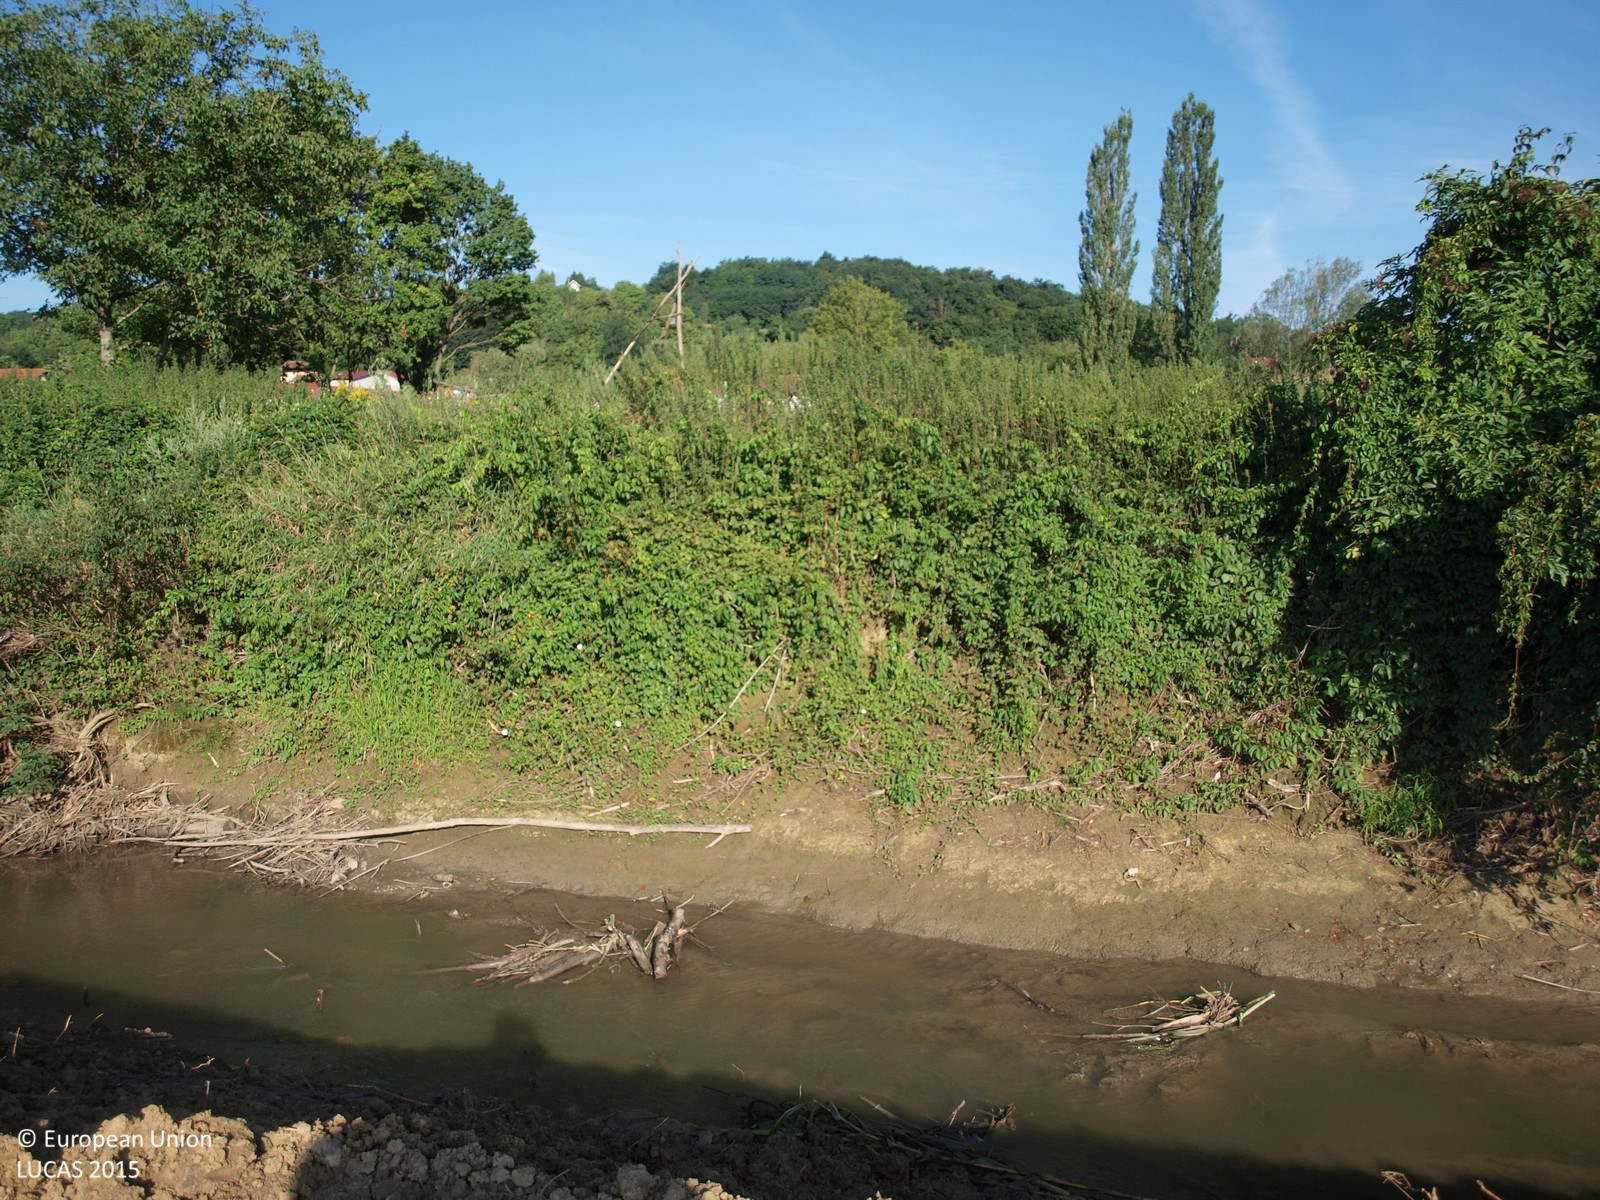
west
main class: Shrubland
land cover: Shrubland with sparse tree cover
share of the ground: > 75 %
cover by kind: shrubs 95 %, broadleaved forest trees 5 %
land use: Semi-natural and natural areas not in use
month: August
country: HR
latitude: 46.0395
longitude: 16.2921
